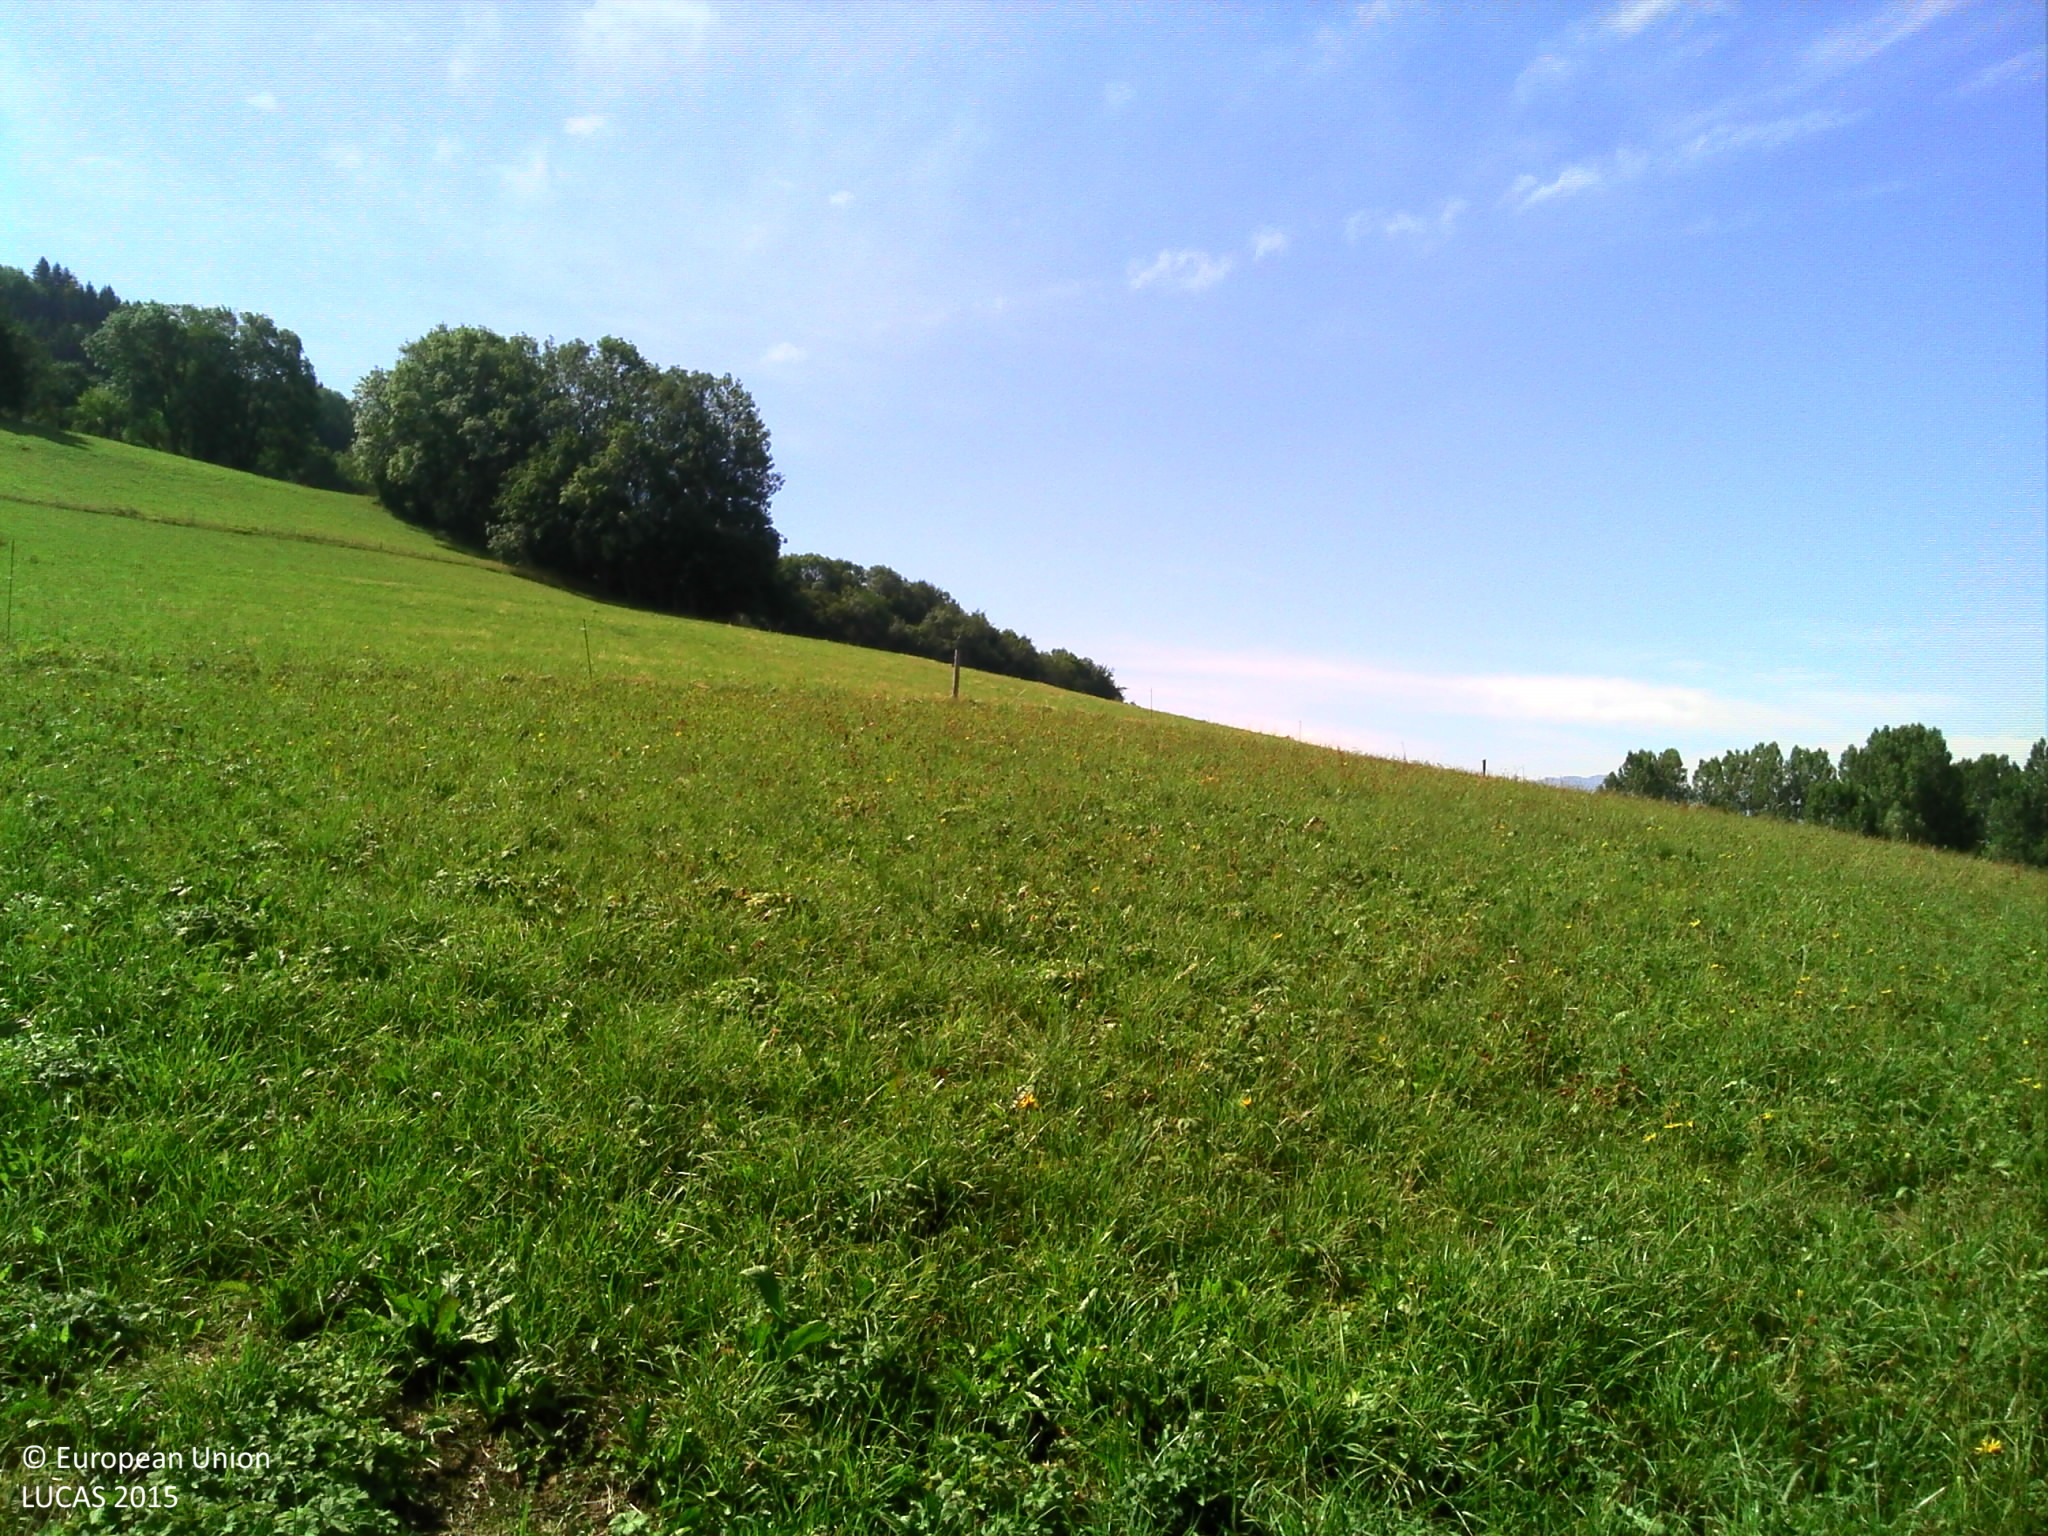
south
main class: Grassland
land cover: Grassland without tree/shrub cover
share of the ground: > 75 %
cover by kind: herbaceous plants 100 %
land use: Agriculture (excluding fallow land and kitchen gardens)
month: July
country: FR
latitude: 46.2018
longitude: 6.4396
